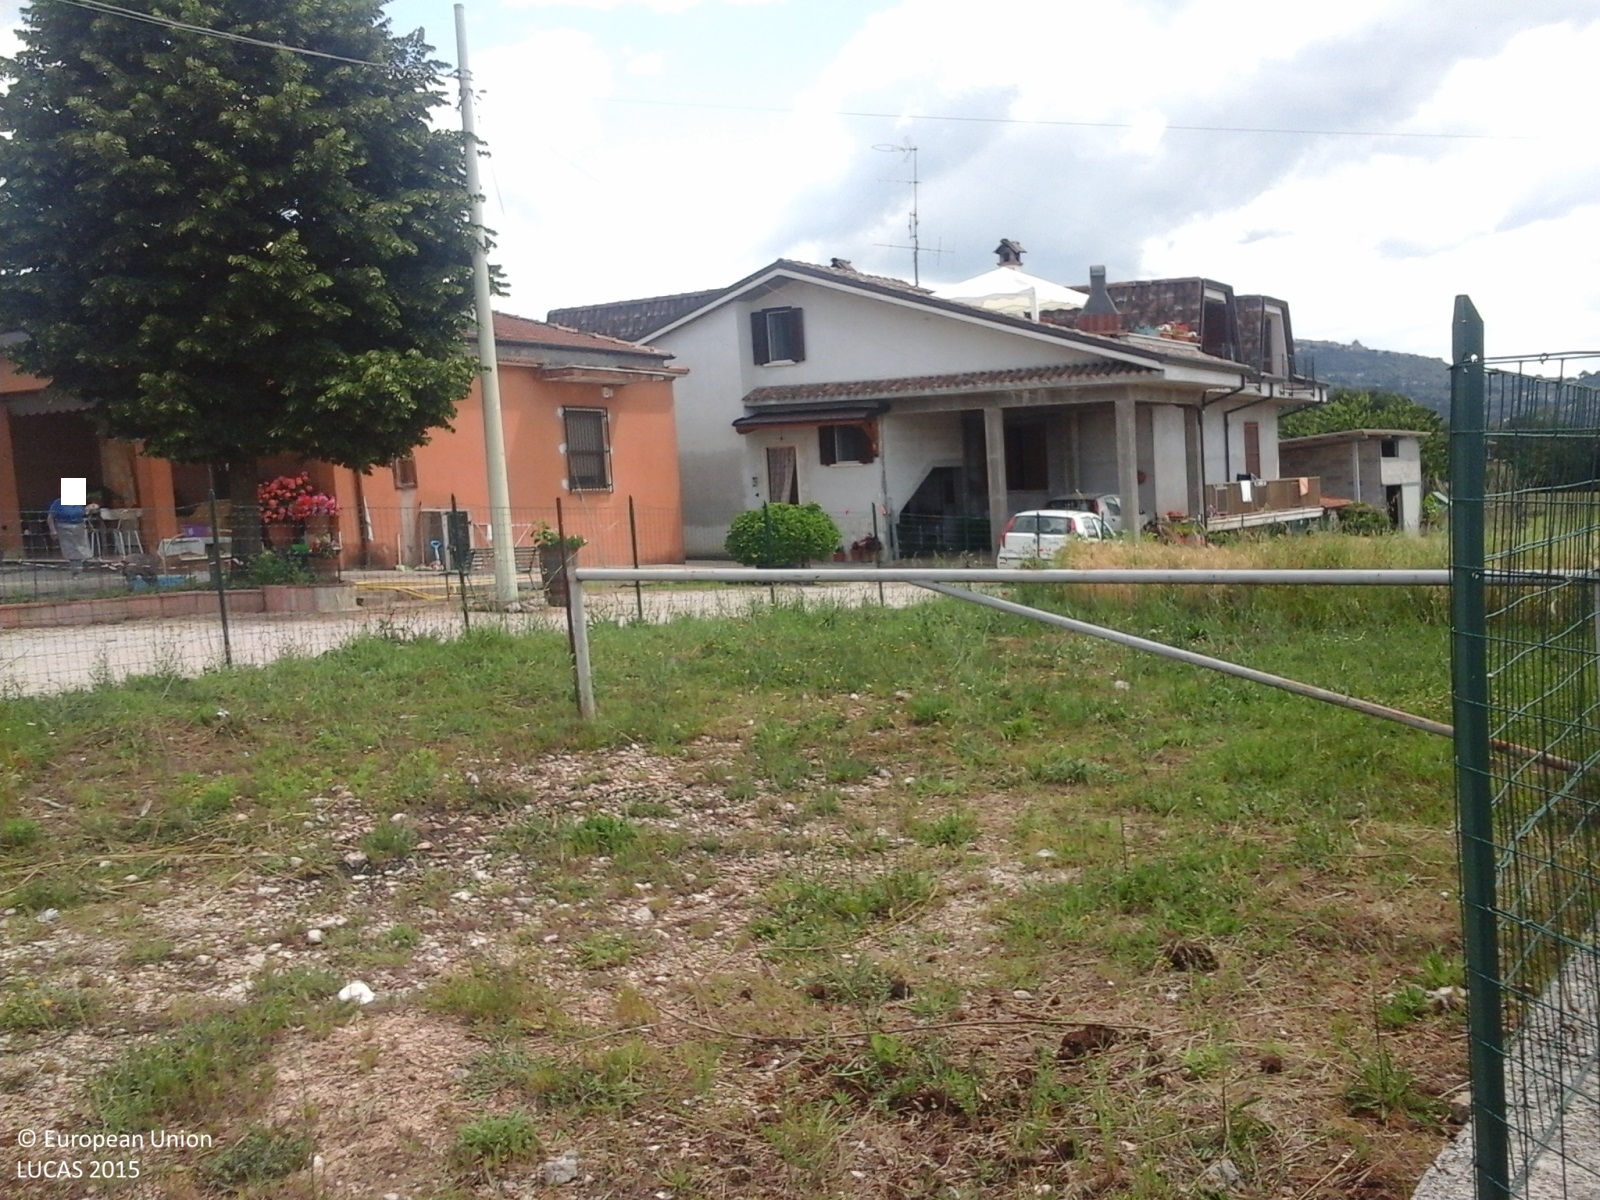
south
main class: Cropland
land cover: Durum wheat
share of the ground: > 75 %
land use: Agriculture (excluding fallow land and kitchen gardens)
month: May
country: IT
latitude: 41.6760
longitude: 13.3628
